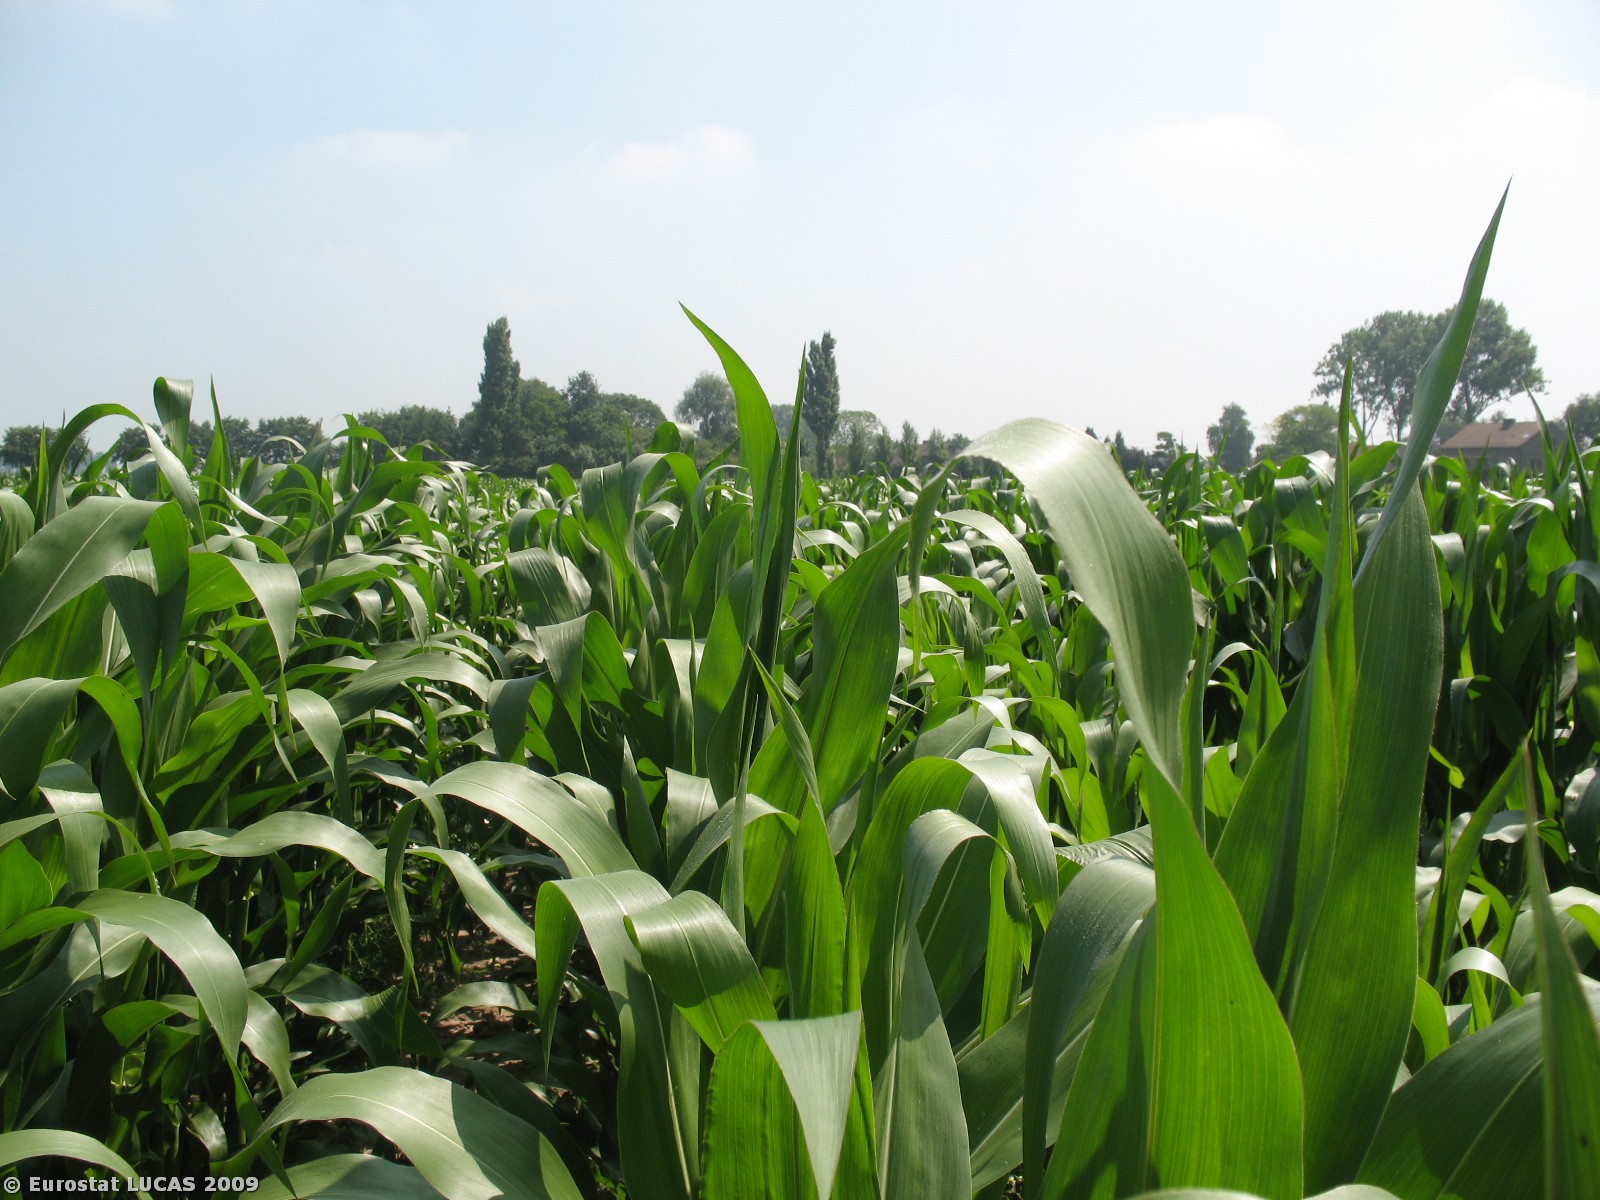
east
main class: Cropland
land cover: Maize
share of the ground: > 75 %
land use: Agriculture (excluding fallow land and kitchen gardens)
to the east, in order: Maize; Grassland without tree/shrub cover; Ditches and canals; Grass margins; Maize; Grass margins; Managed hedges; Broadleaved woodland
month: June
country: BE
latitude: 51.2531
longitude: 3.6742
